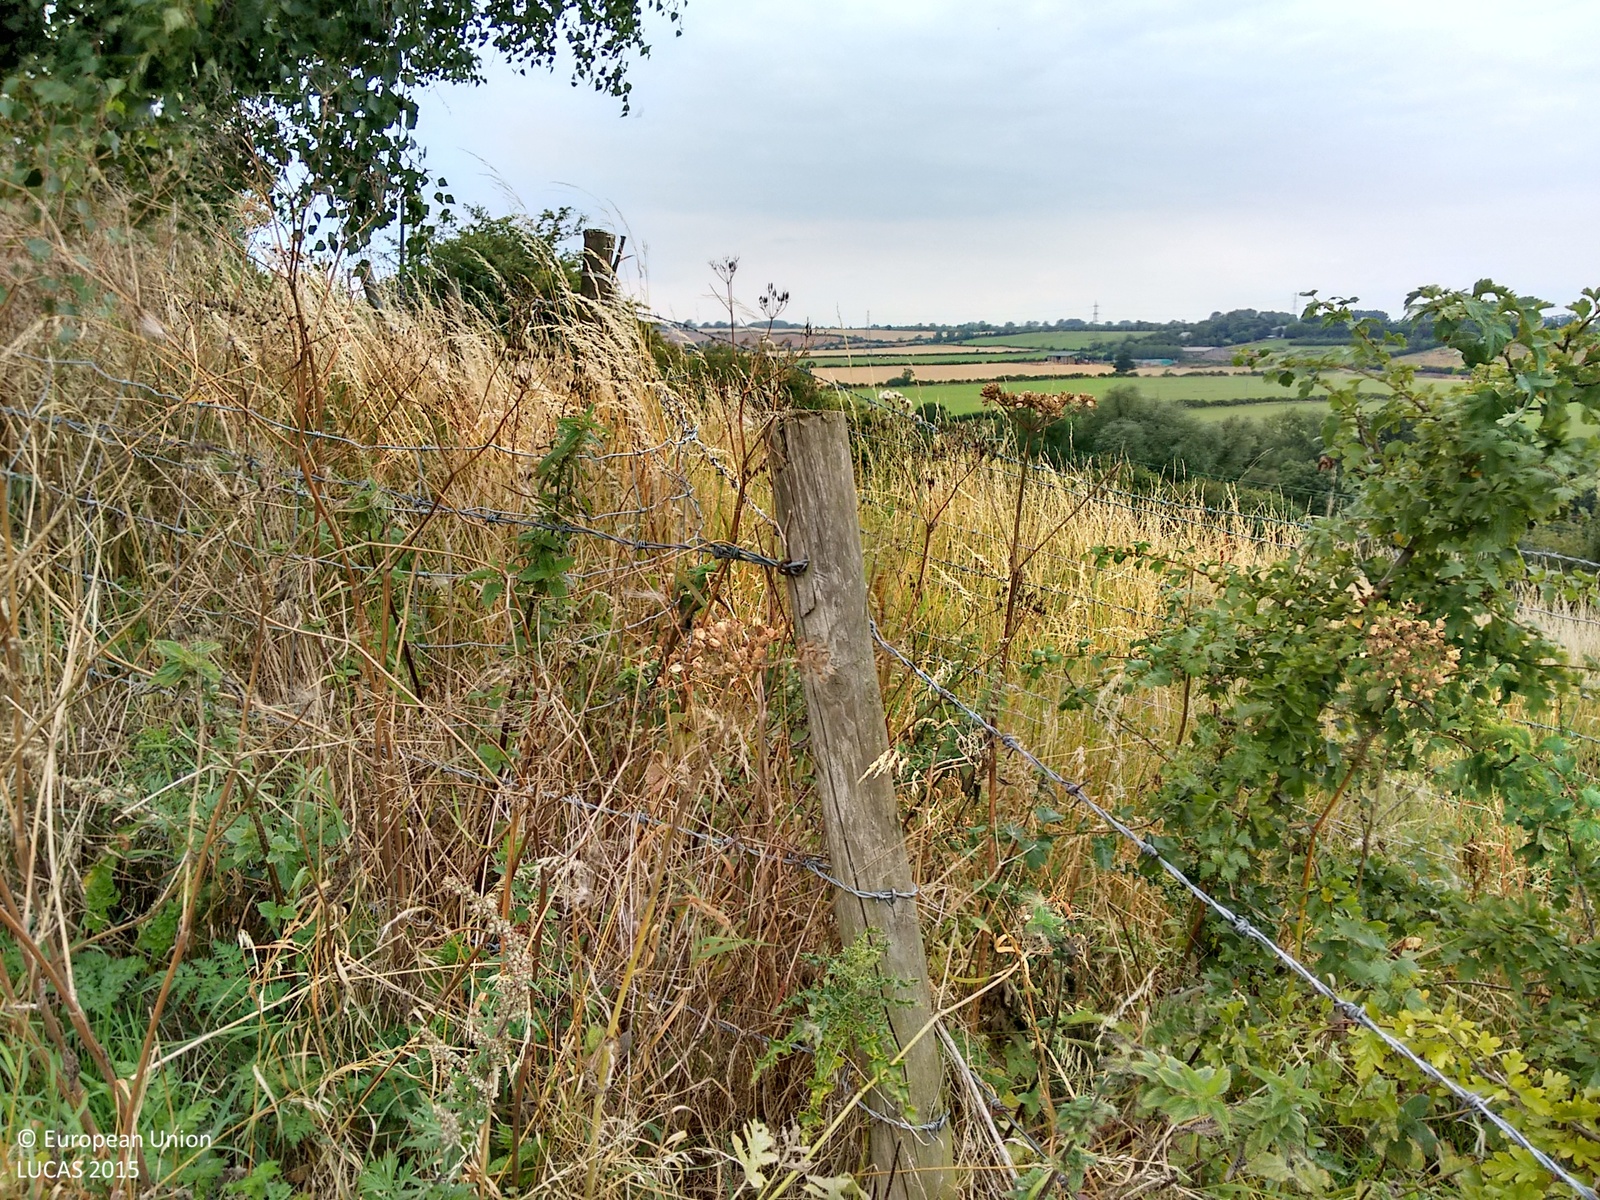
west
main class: Shrubland
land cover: Shrubland with sparse tree cover
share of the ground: > 75 %
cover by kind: shrubs 75 %, herbaceous plants 20 %, broadleaved forest trees 5 %
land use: Semi-natural and natural areas not in use
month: August
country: GB
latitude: 52.4078
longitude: -0.8170
